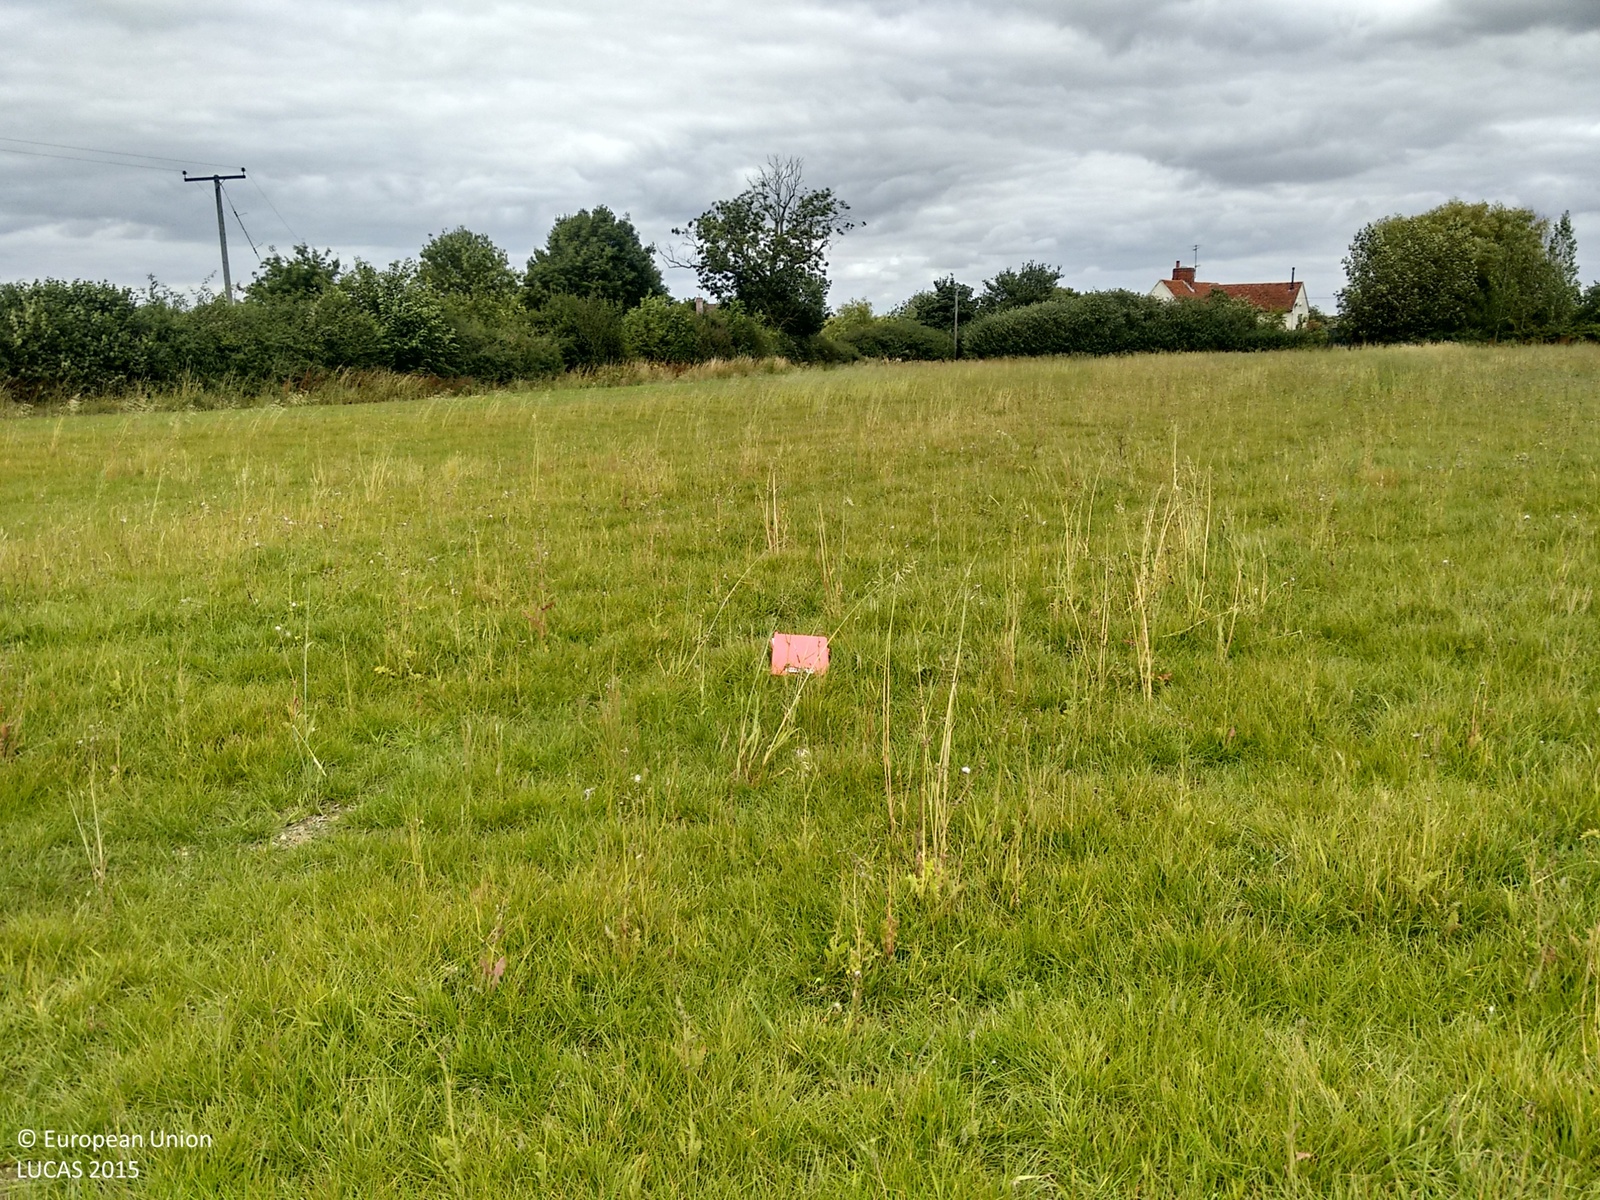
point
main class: Grassland
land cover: Grassland without tree/shrub cover
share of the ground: > 75 %
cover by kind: herbaceous plants 100 %
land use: Agriculture (excluding fallow land and kitchen gardens)
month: August
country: GB
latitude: 52.0057
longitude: 0.4003
